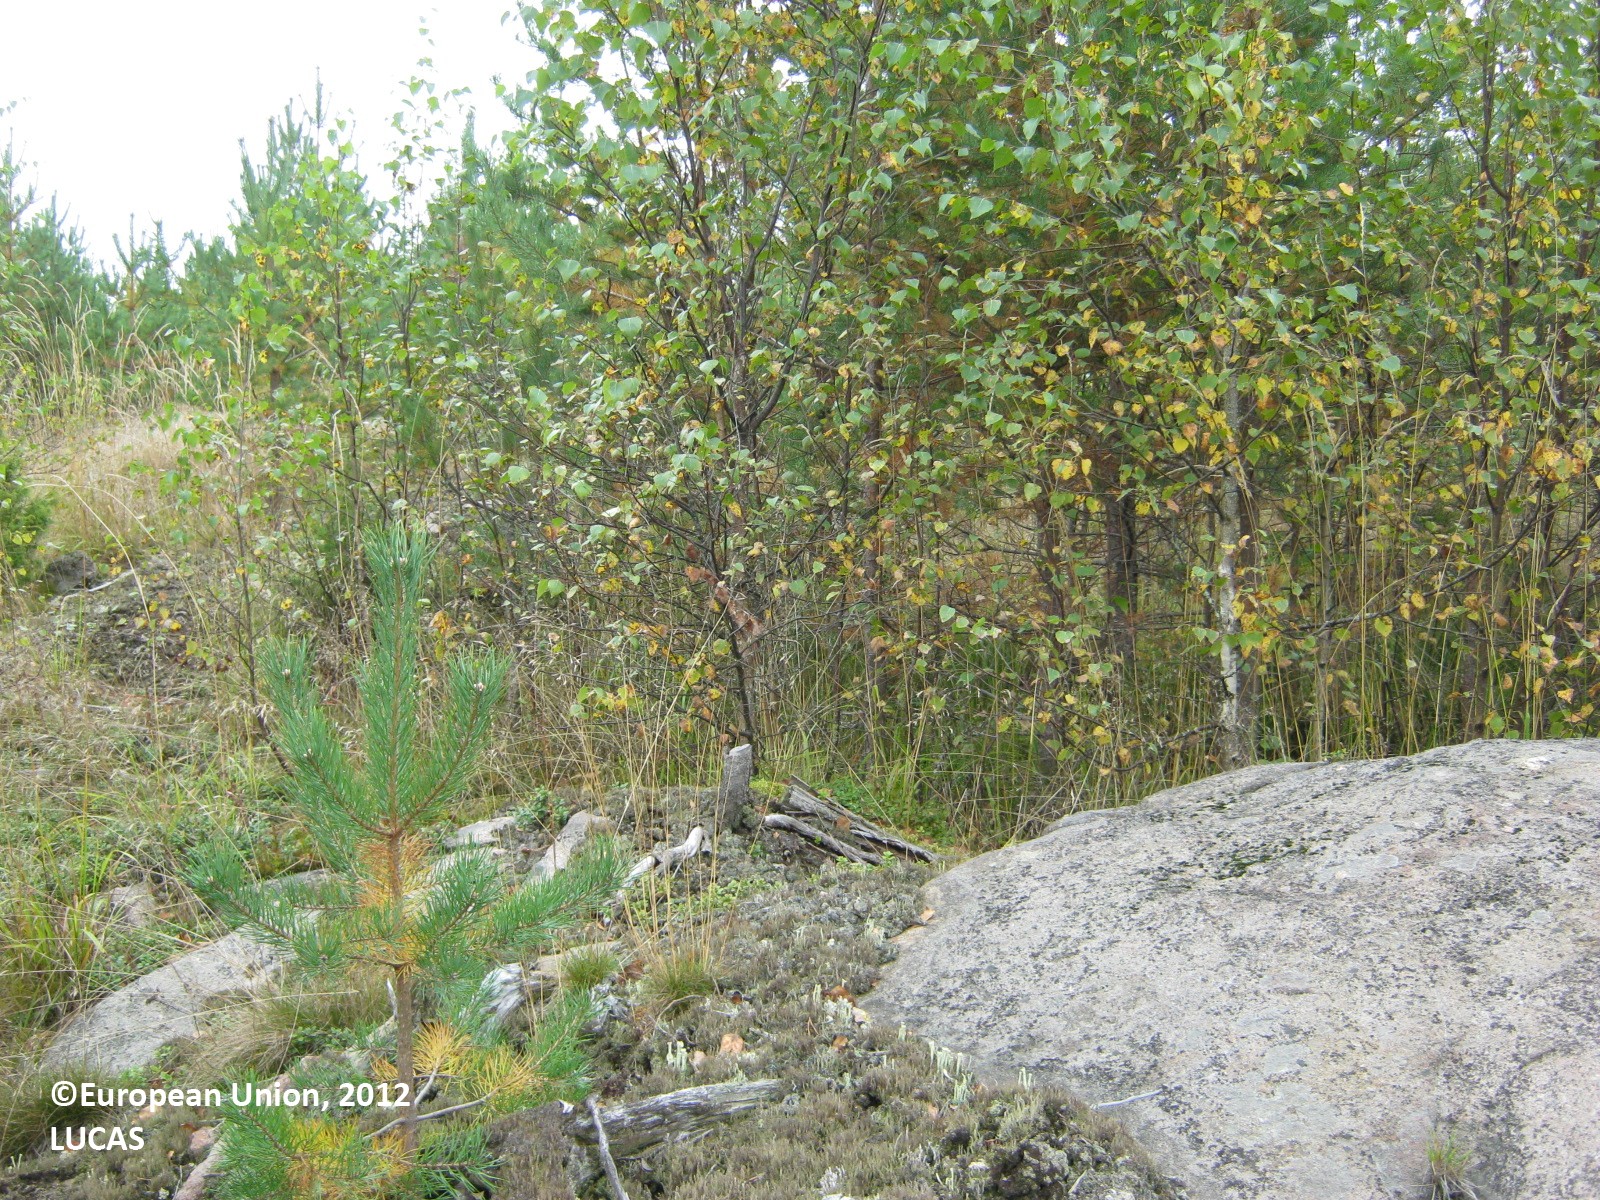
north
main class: Woodland
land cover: Pine dominated mixed woodland
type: boreal forest
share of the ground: > 75 %
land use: Forestry
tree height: < 5 m
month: September
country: FI
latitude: 60.8261
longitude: 28.1359
